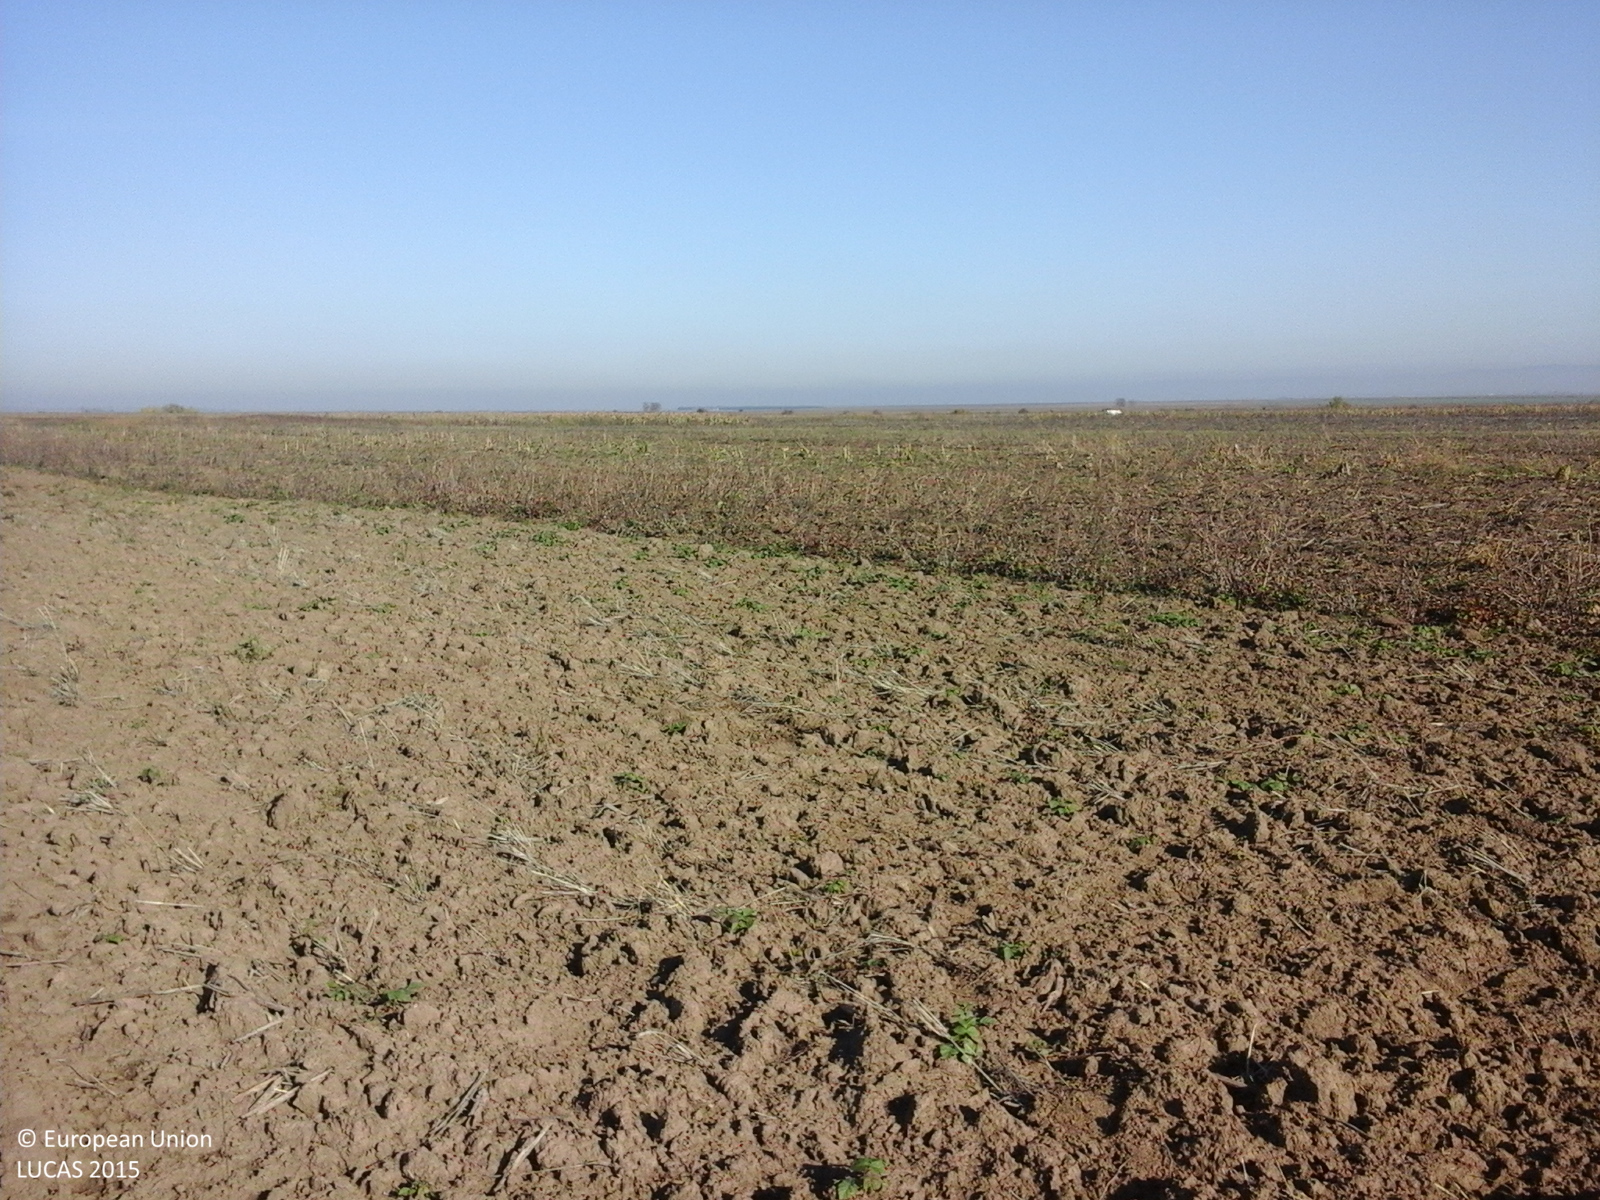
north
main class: Cropland
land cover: Common wheat
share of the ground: < 10 %
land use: Agriculture (excluding fallow land and kitchen gardens)
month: October
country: RO
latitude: 45.9442
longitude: 27.1622
